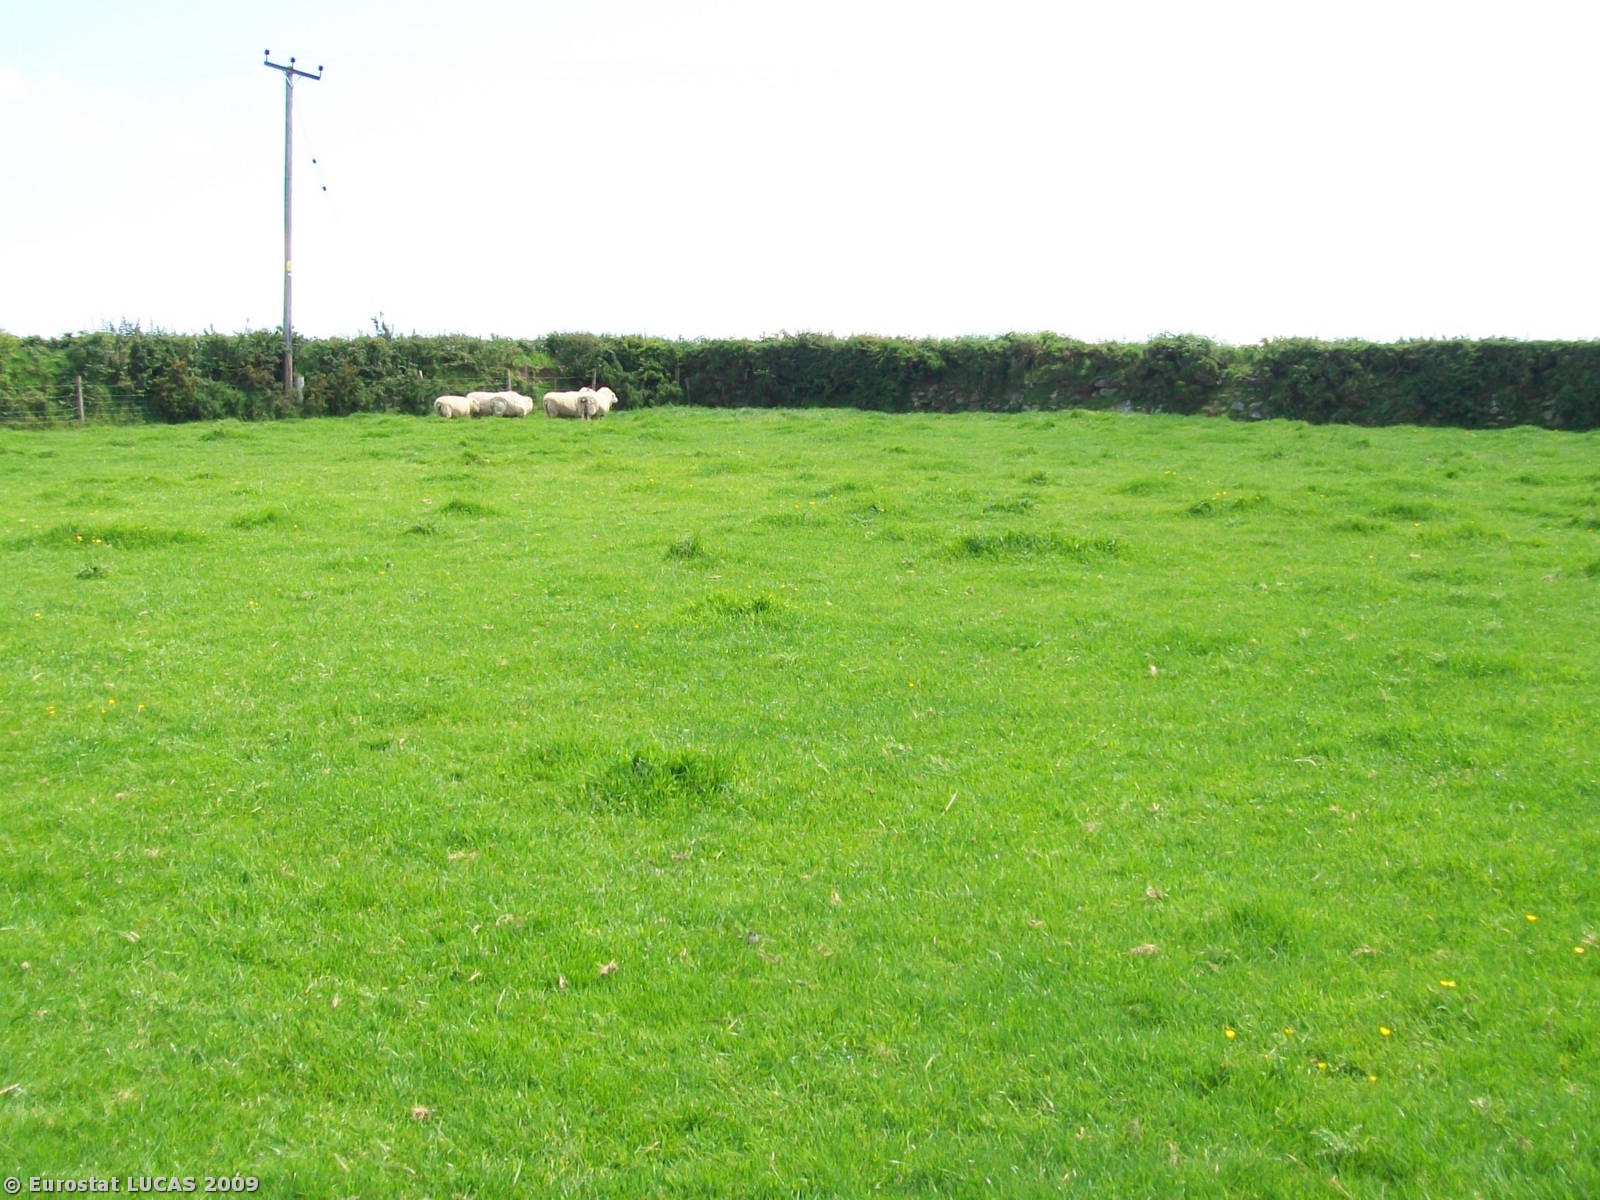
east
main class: Grassland
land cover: Grassland without tree/shrub cover
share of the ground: > 75 %
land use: Agriculture (excluding fallow land and kitchen gardens)
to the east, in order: Grassland without tree/shrub cover; Fences; Managed hedges; Grassland without tree/shrub cover; Fences; Managed hedges; Grassland without tree/shrub cover; Managed hedges
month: June
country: GB
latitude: 50.4869
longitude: -4.5523
